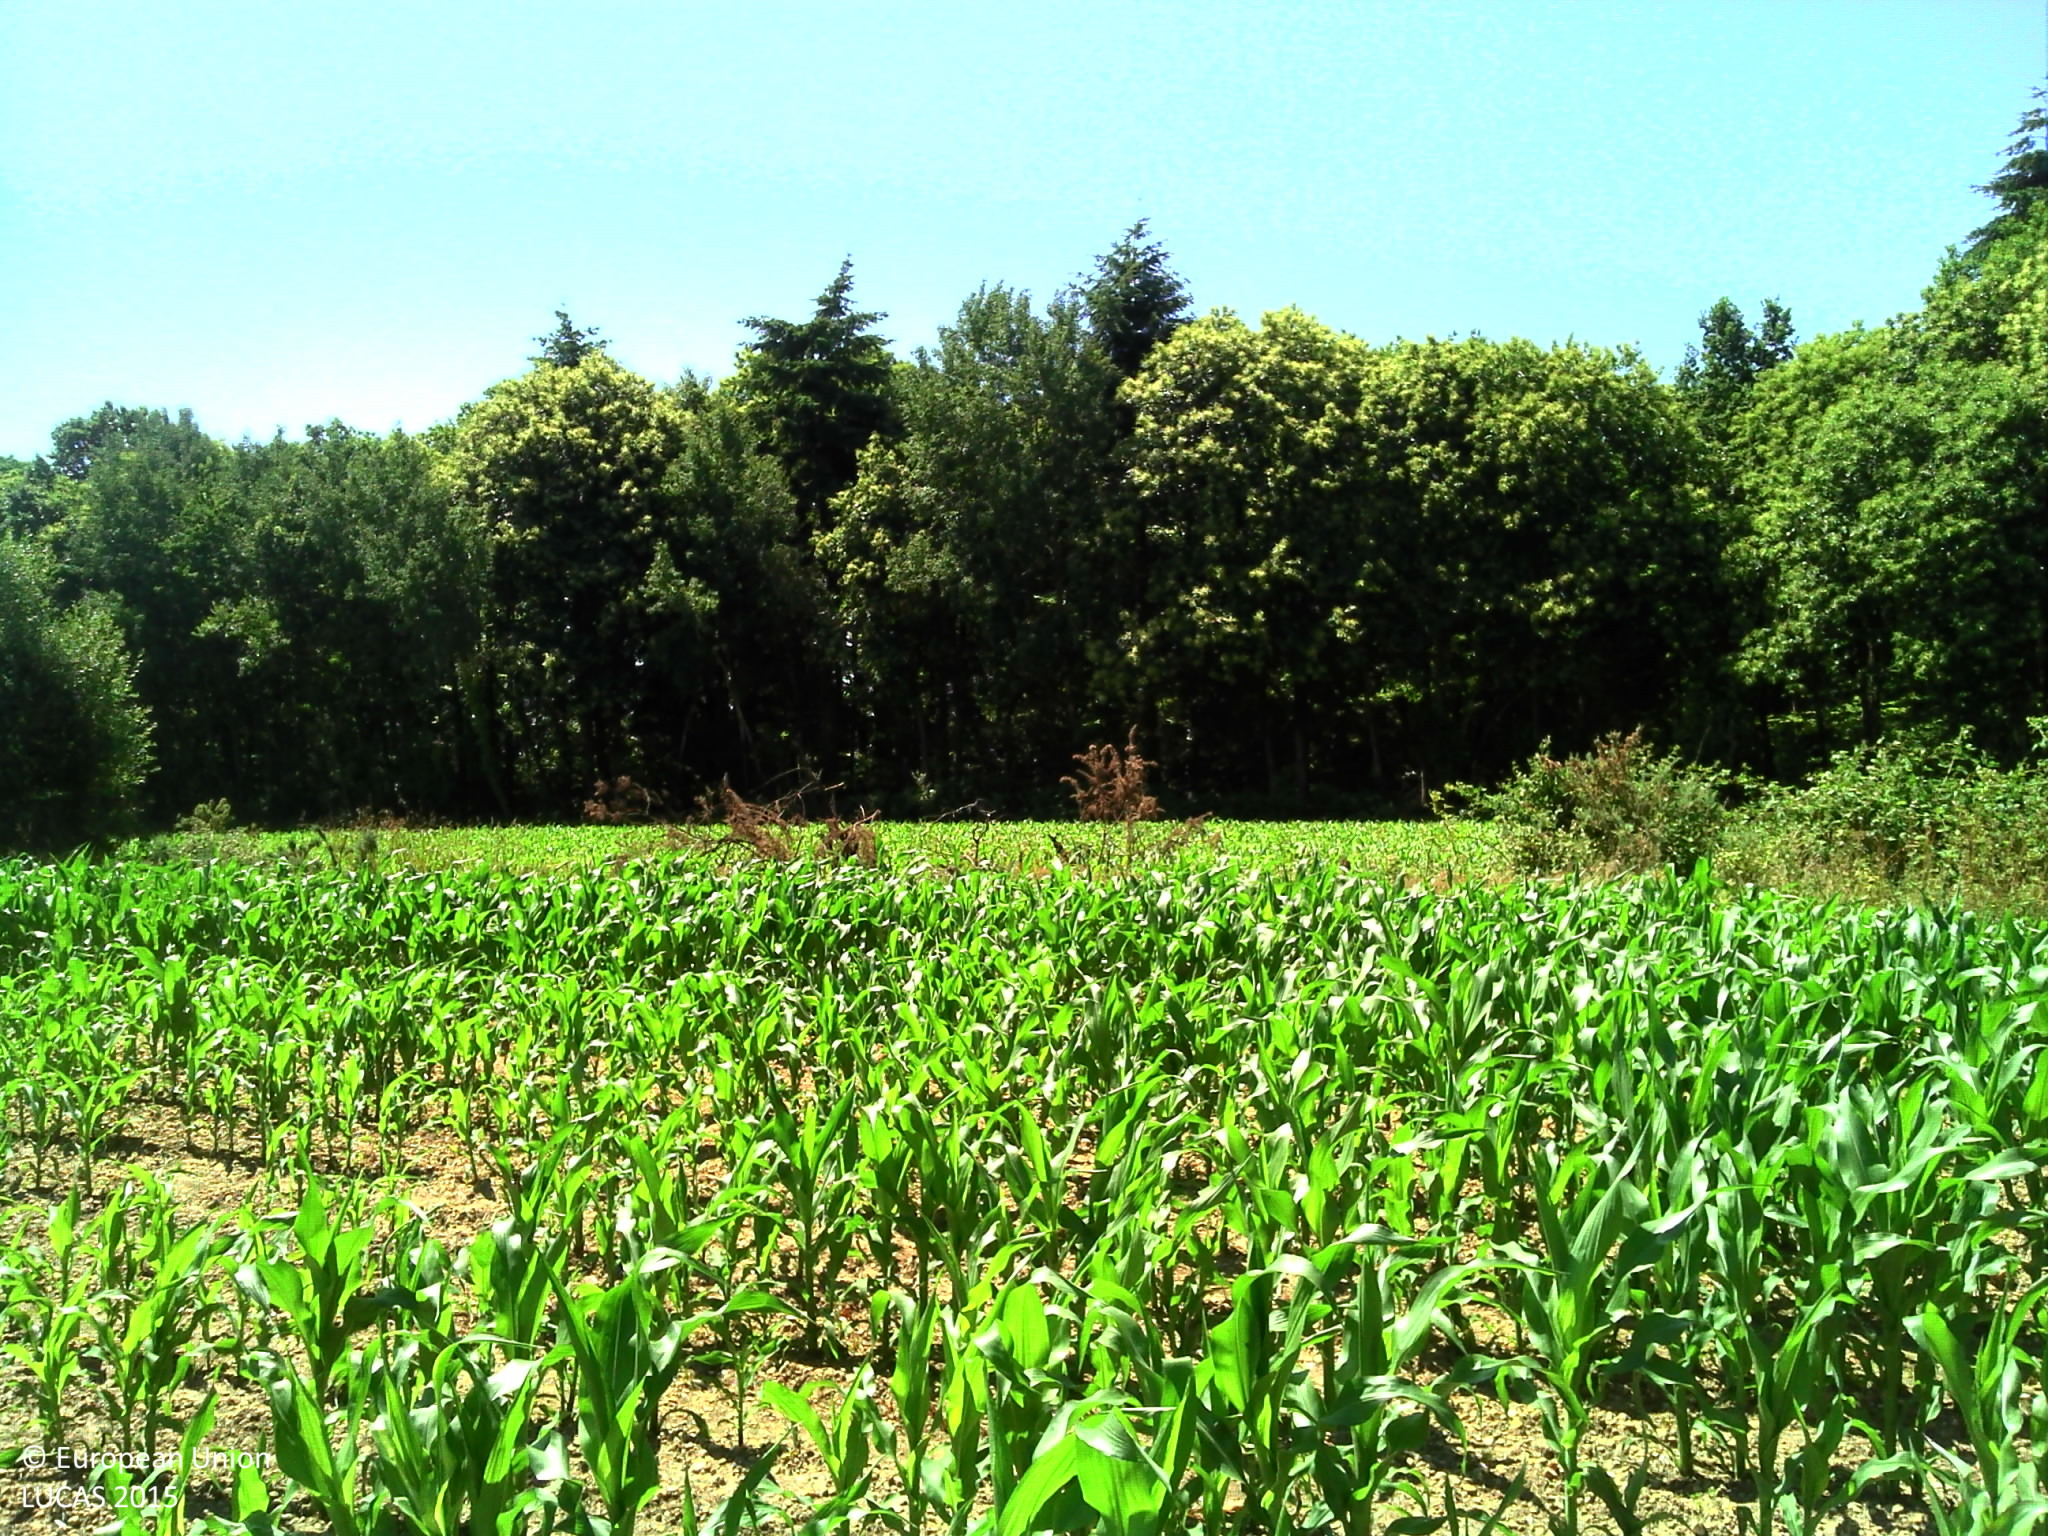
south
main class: Cropland
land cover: Maize
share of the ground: 25 - 50 %
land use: Agriculture (excluding fallow land and kitchen gardens)
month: June
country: FR
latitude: 48.5740
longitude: -1.5824
